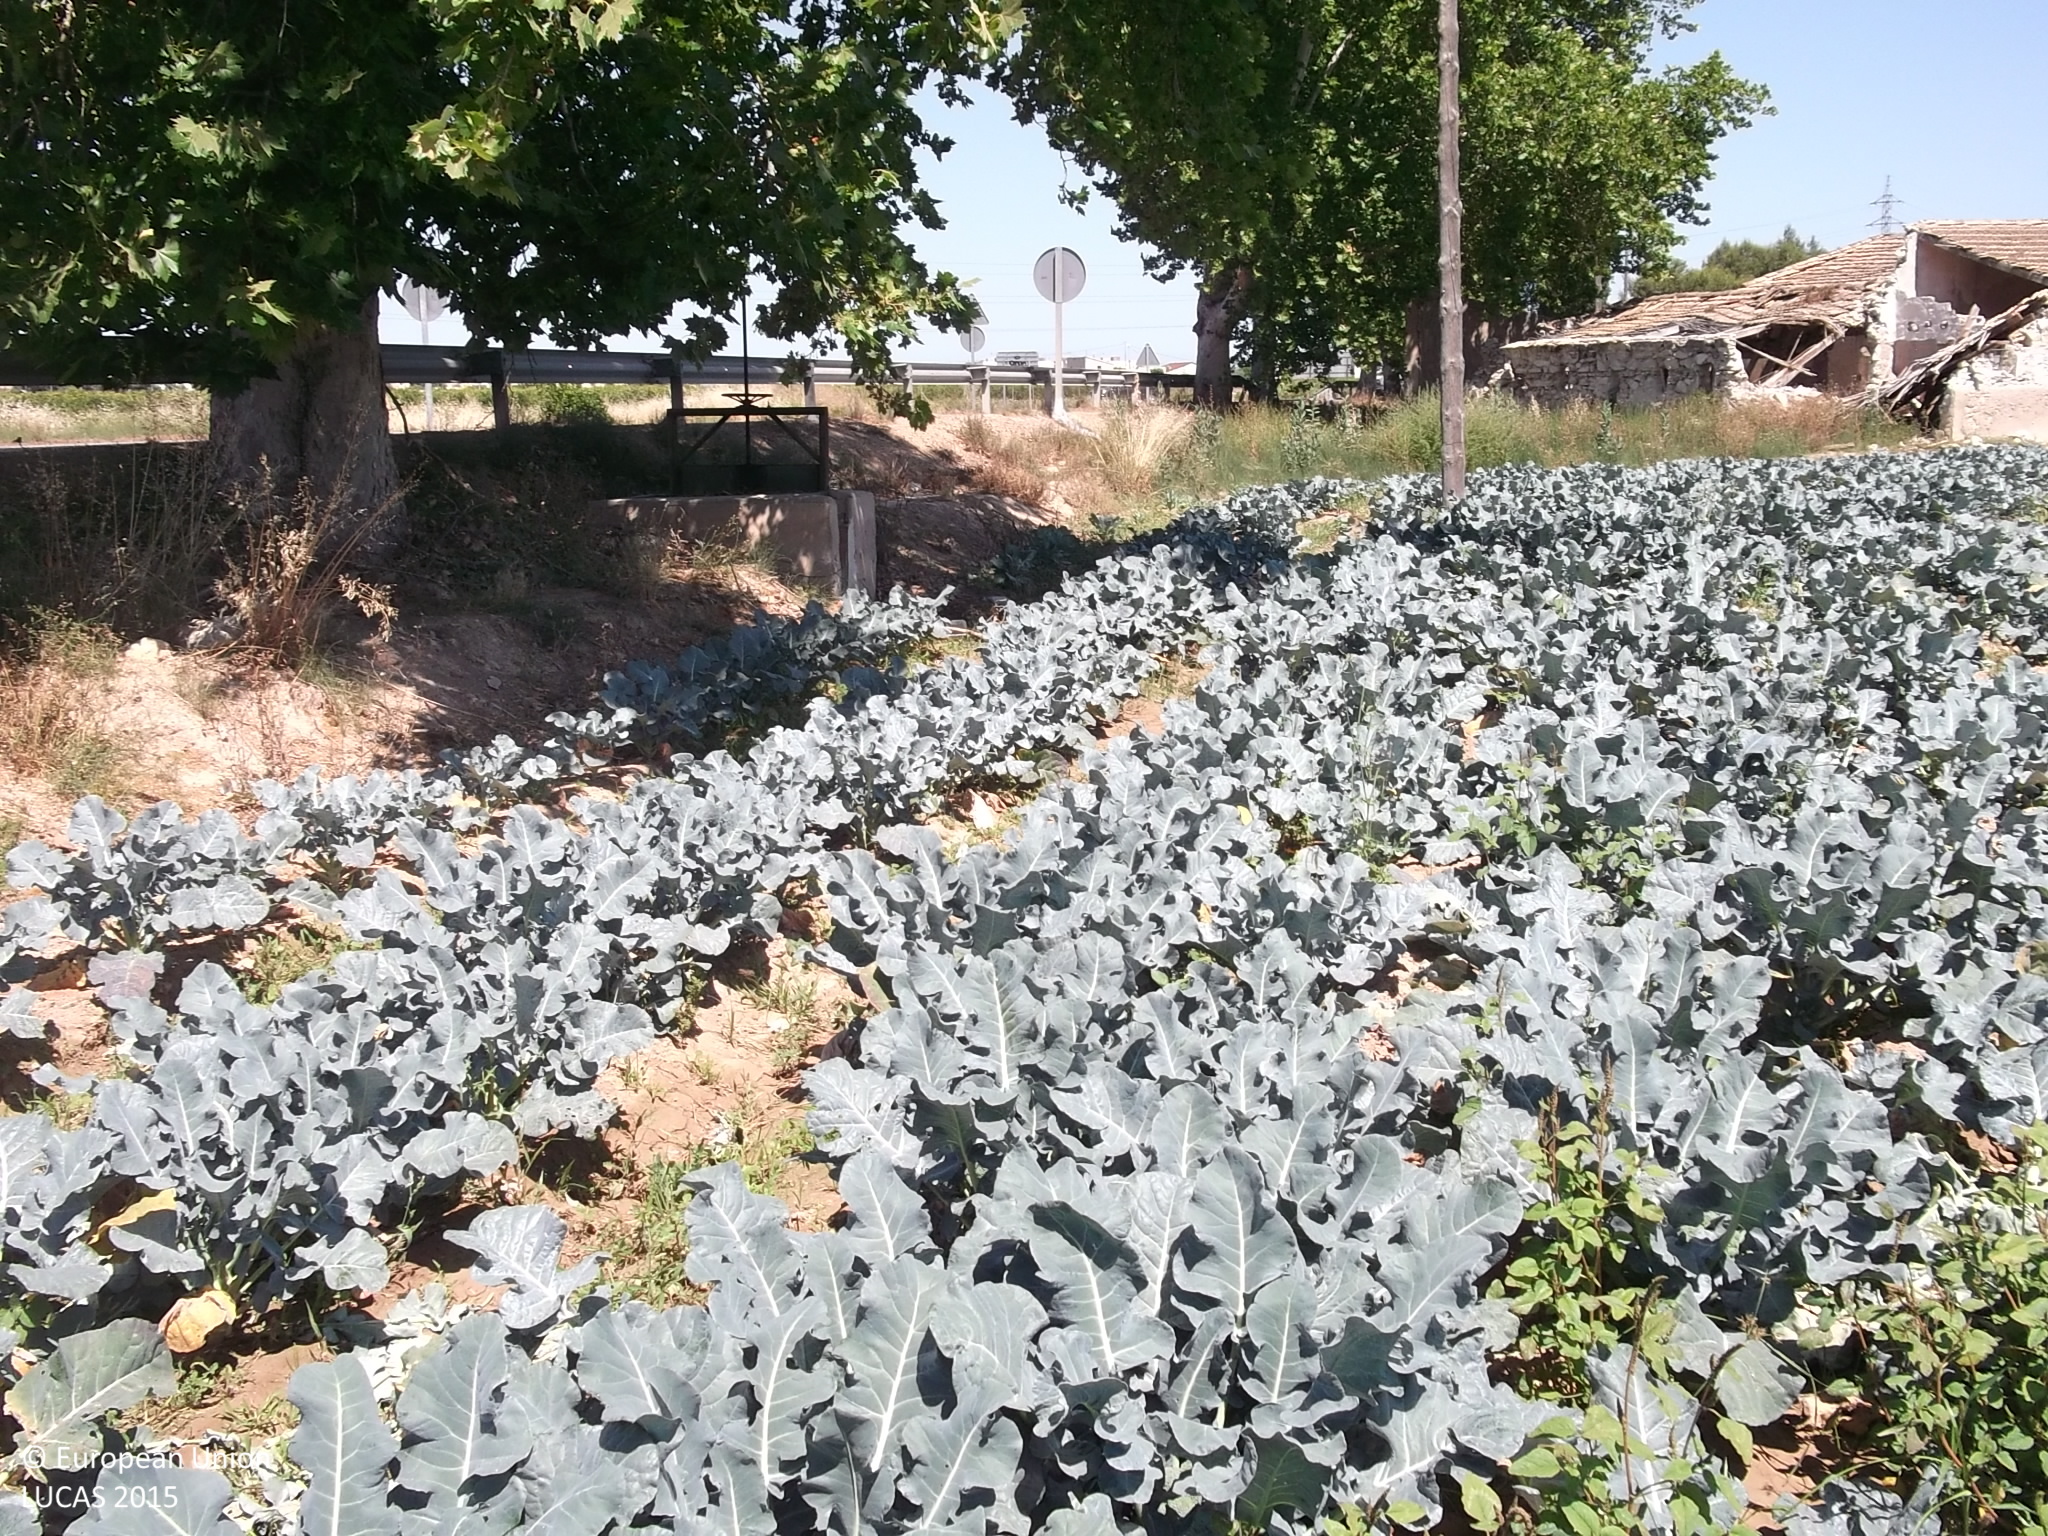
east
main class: Cropland
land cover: Other fresh vegetables
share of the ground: > 75 %
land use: Agriculture (excluding fallow land and kitchen gardens)
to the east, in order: Other fresh vegetables; Grass margins; Groves; Paved roads, cycling and walking lanes; Grass margins; Fences; Other fresh vegetables; Fences; Paved roads, cycling and walking lanes; Grass margins; Other citrus fruit; Electric lines; Other citrus fruit; Grass margins; Other citrus fruit
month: May
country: ES
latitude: 38.0910
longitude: -0.8730
